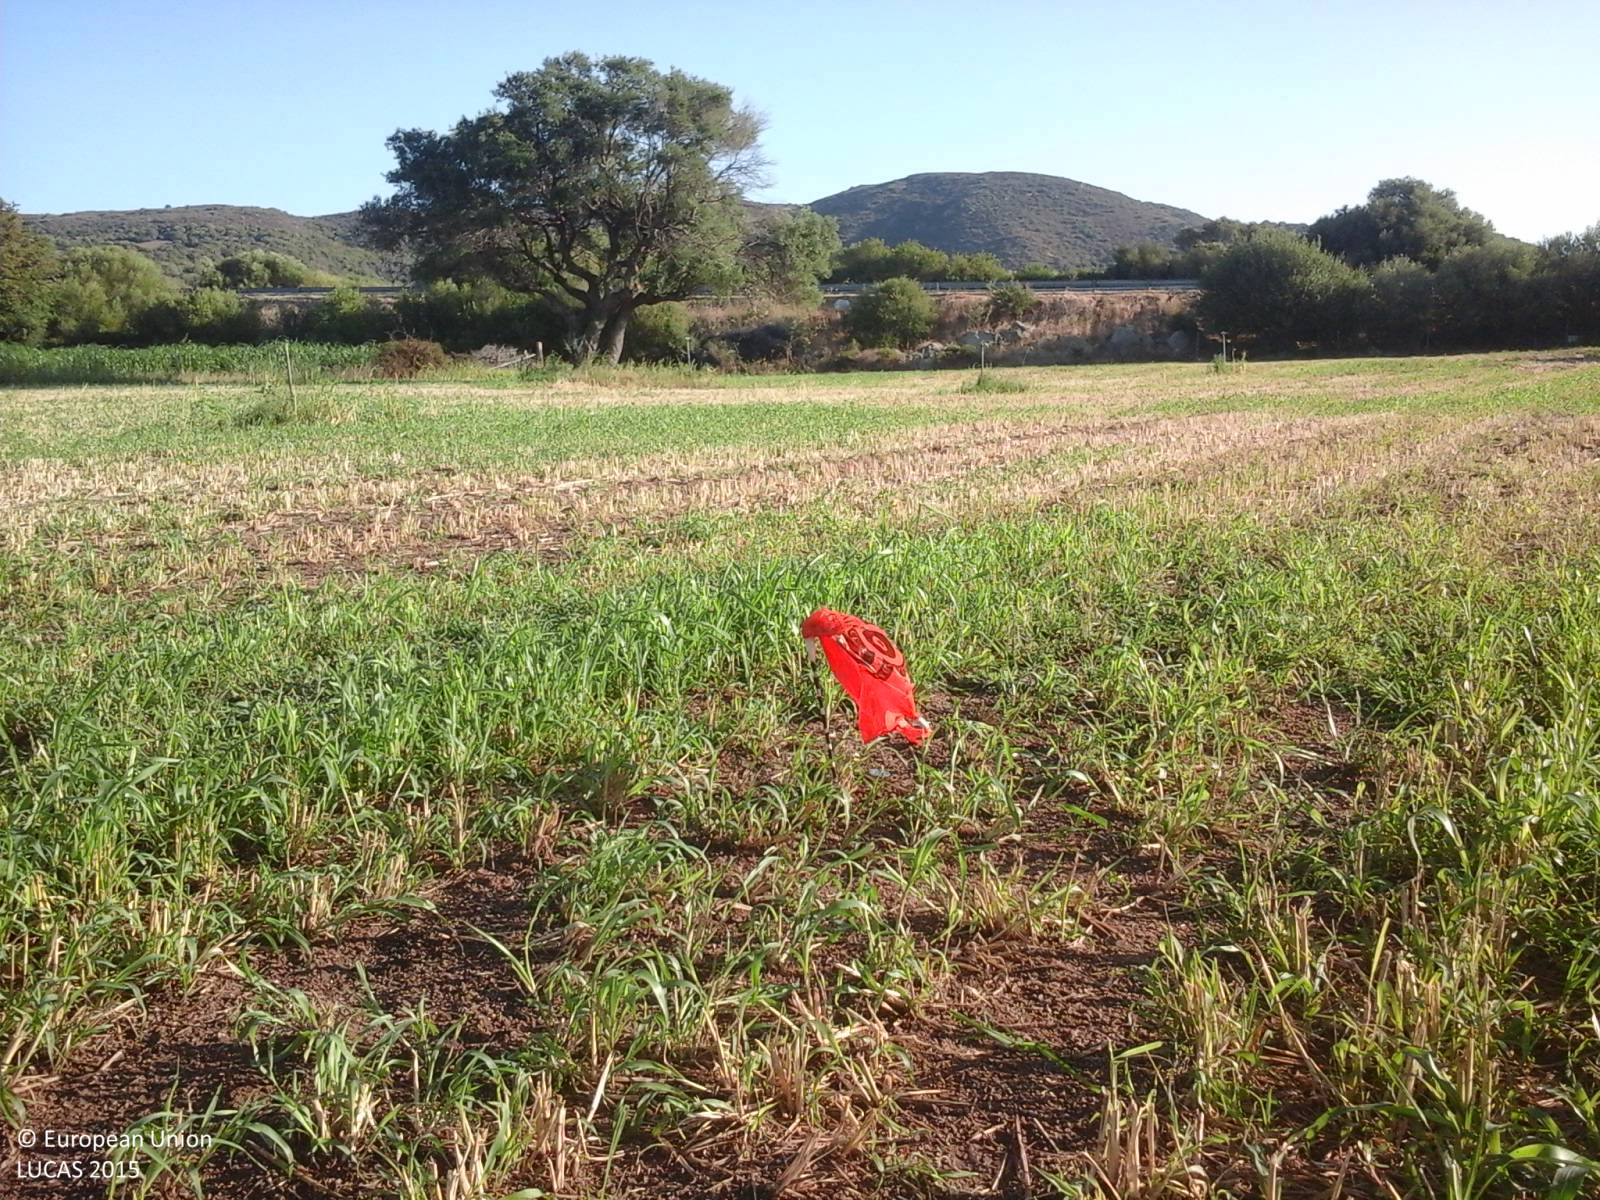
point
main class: Grassland
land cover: Grassland without tree/shrub cover
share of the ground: > 75 %
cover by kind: herbaceous plants 95 %, unconsolidated bare surface 5 %
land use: Agriculture (excluding fallow land and kitchen gardens)
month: August
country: IT
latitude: 40.9352
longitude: 9.4208
